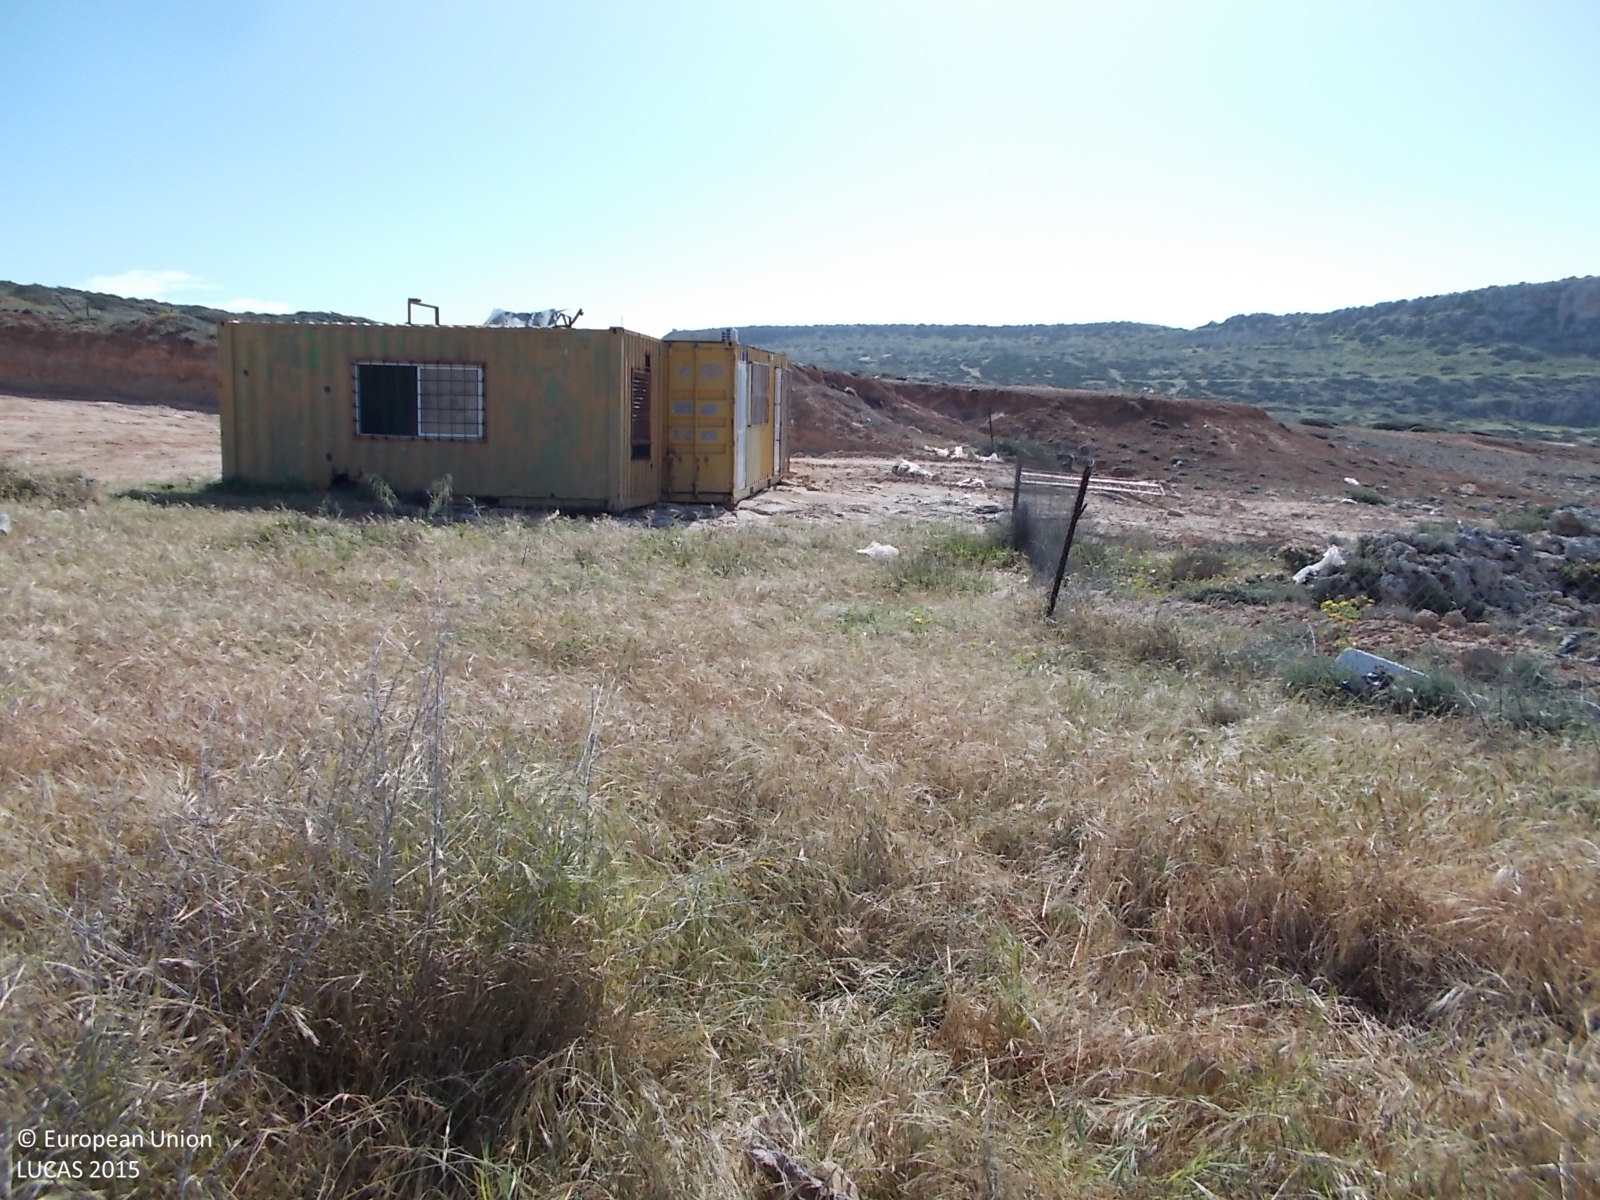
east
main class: Grassland
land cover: Grassland without tree/shrub cover
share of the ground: > 75 %
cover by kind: herbaceous plants 100 %
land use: Semi-natural and natural areas not in use
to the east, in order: Grassland without tree/shrub cover; Tracks; Other bare soil; Fences; Other bare soil; Shrubland without tree cover; Other bare soil; Tracks; Grassland without tree/shrub cover; Grassland with sparse tree/shrub cover; Tracks; Grassland with sparse tree/shrub cover; Shrubland without tree cover; Rocks and stones
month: March
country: CY
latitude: 34.9673
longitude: 34.0600
